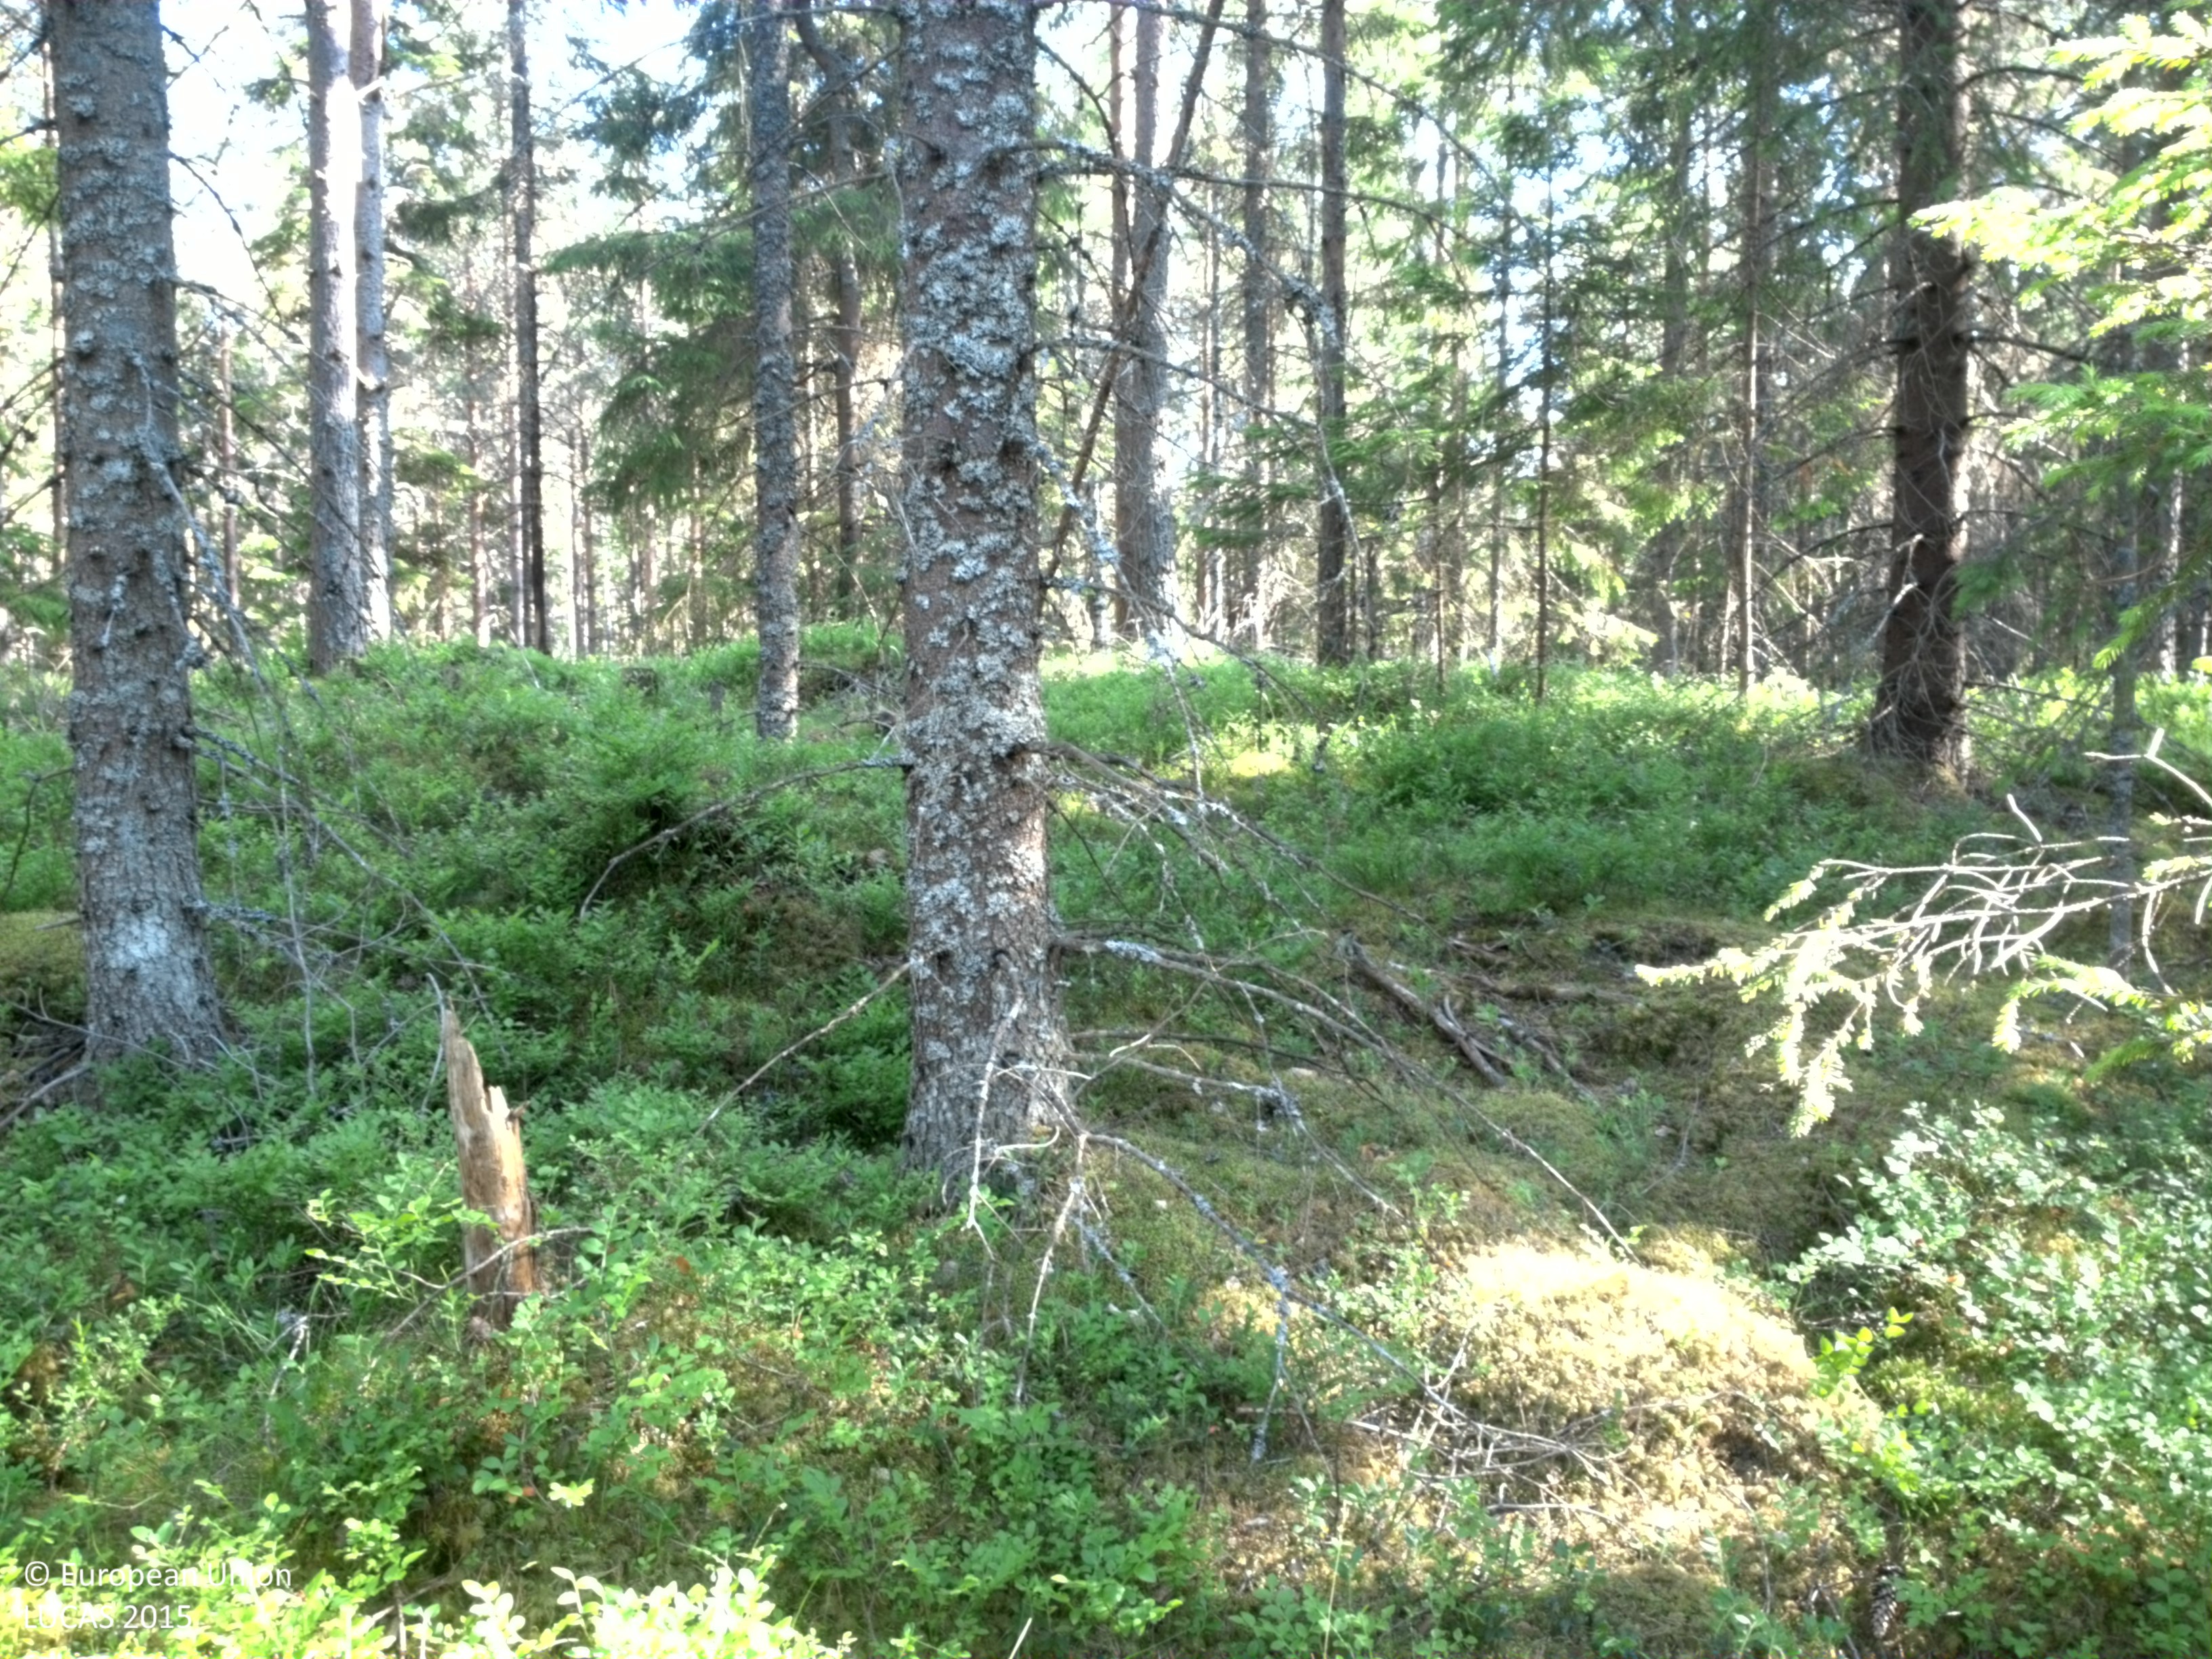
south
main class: Woodland
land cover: Pine dominated mixed woodland
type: boreal forest
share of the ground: 50 - 75 %
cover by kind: coniferous forest trees 40 %, shrubs 30 %, broadleaved forest trees 20 %, herbaceous plants 5 %, consolidated bare surface 5 %
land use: Forestry
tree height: > 5 m
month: July
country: SE
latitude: 59.1695
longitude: 14.5576
